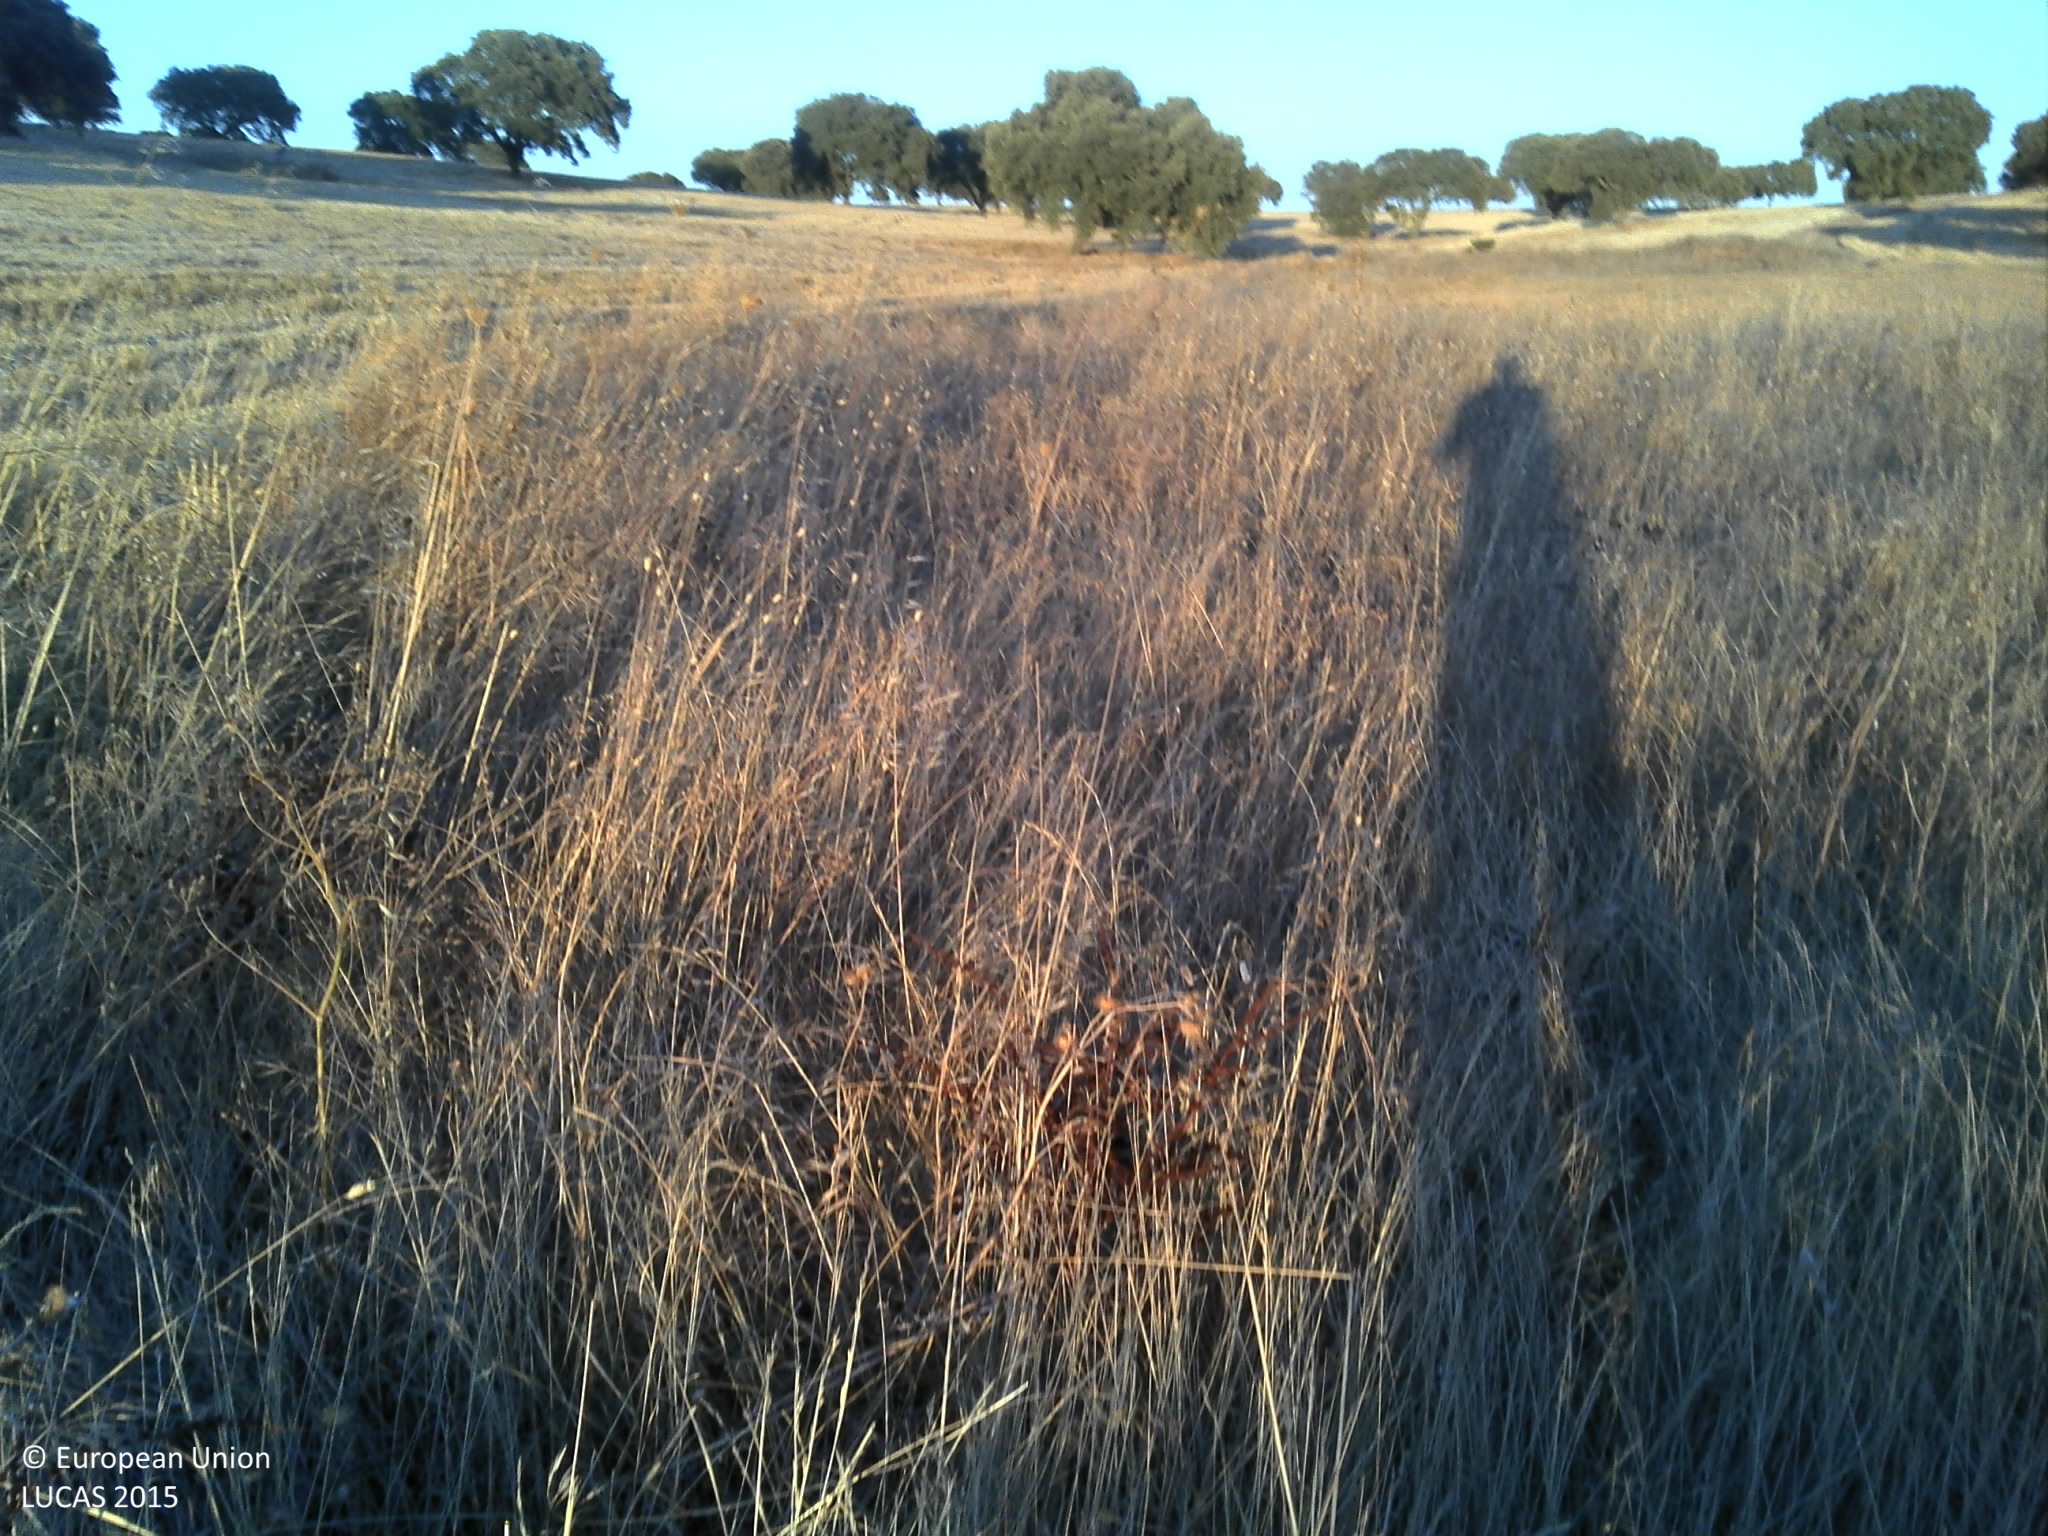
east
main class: Grassland
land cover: Grassland without tree/shrub cover
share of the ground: > 75 %
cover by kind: herbaceous plants 100 %
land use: Agriculture (excluding fallow land and kitchen gardens)
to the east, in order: Grassland without tree/shrub cover; Rivers and streams; Grass margins; Barley
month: July
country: PT
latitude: 37.8440
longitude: -8.0169
